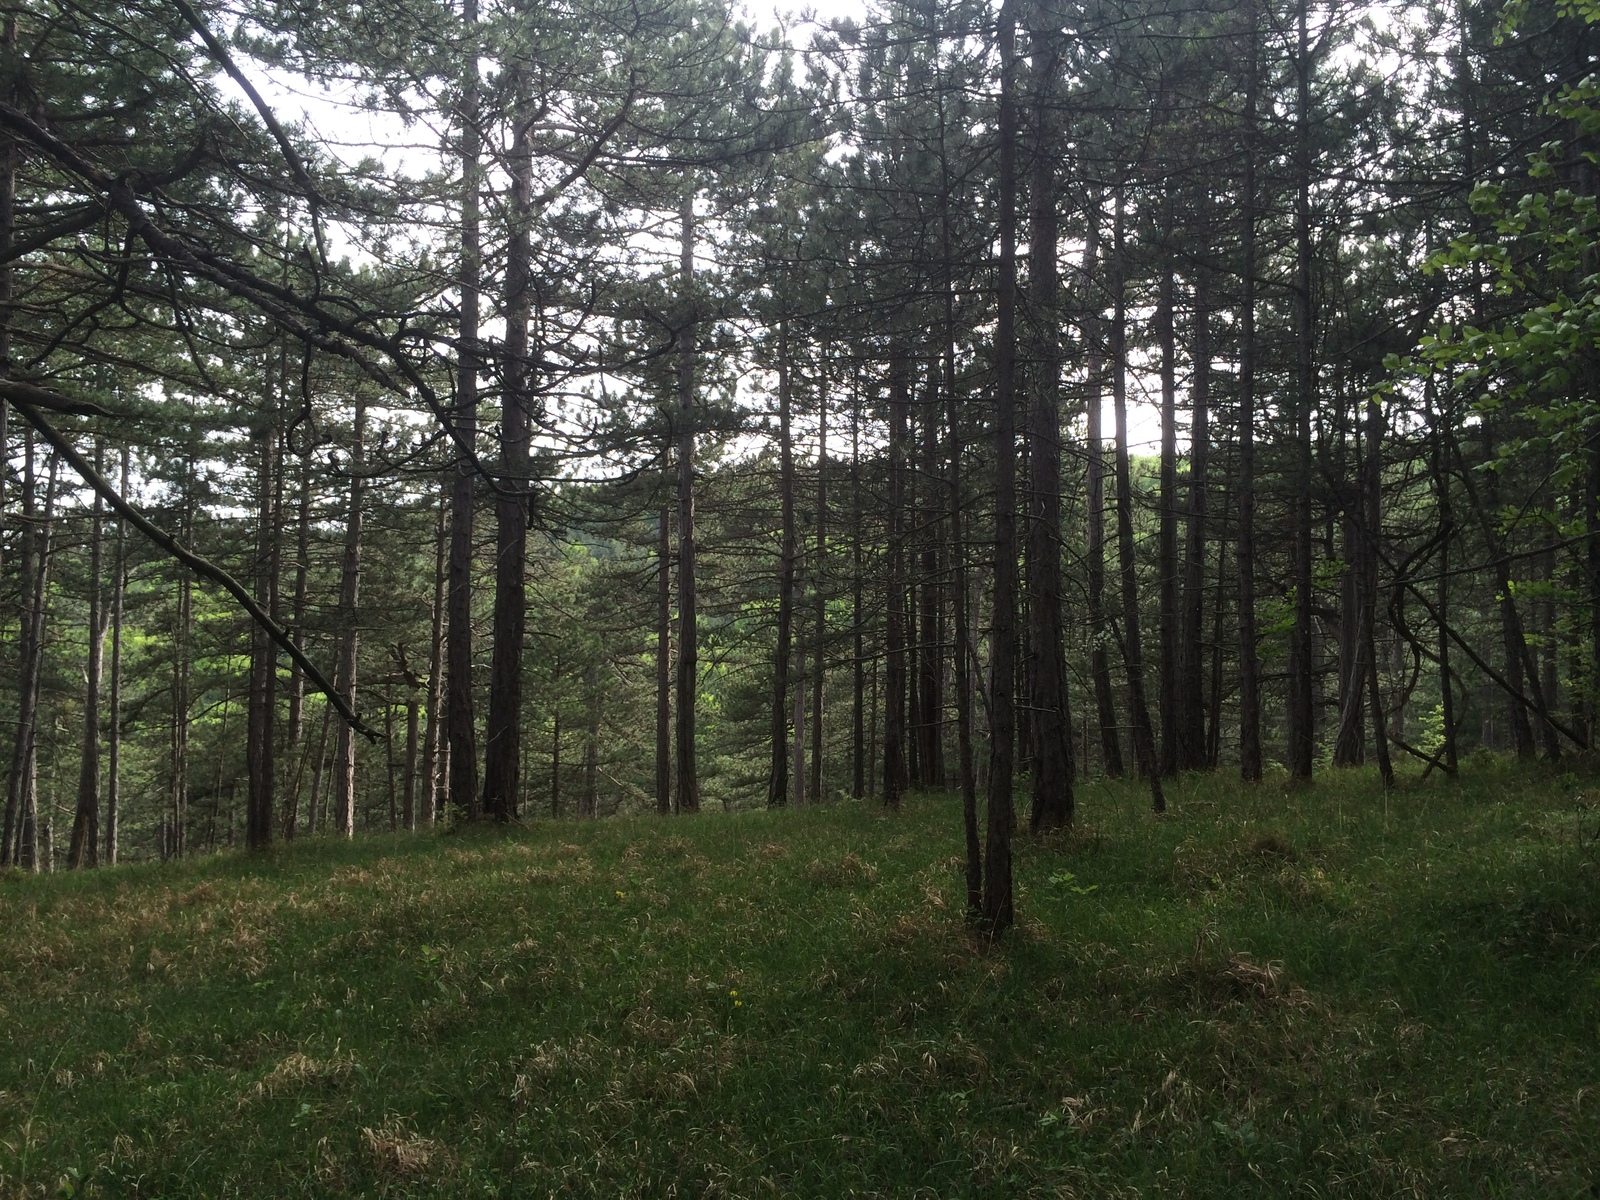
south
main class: Woodland
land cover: Pine dominated coniferous woodland
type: alpine coniferous forest
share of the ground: > 75 %
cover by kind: coniferous forest trees 95 %, broadleaved forest trees 5 %
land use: Forestry
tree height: > 5 m
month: May
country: AT
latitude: 47.9108
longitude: 16.0911
